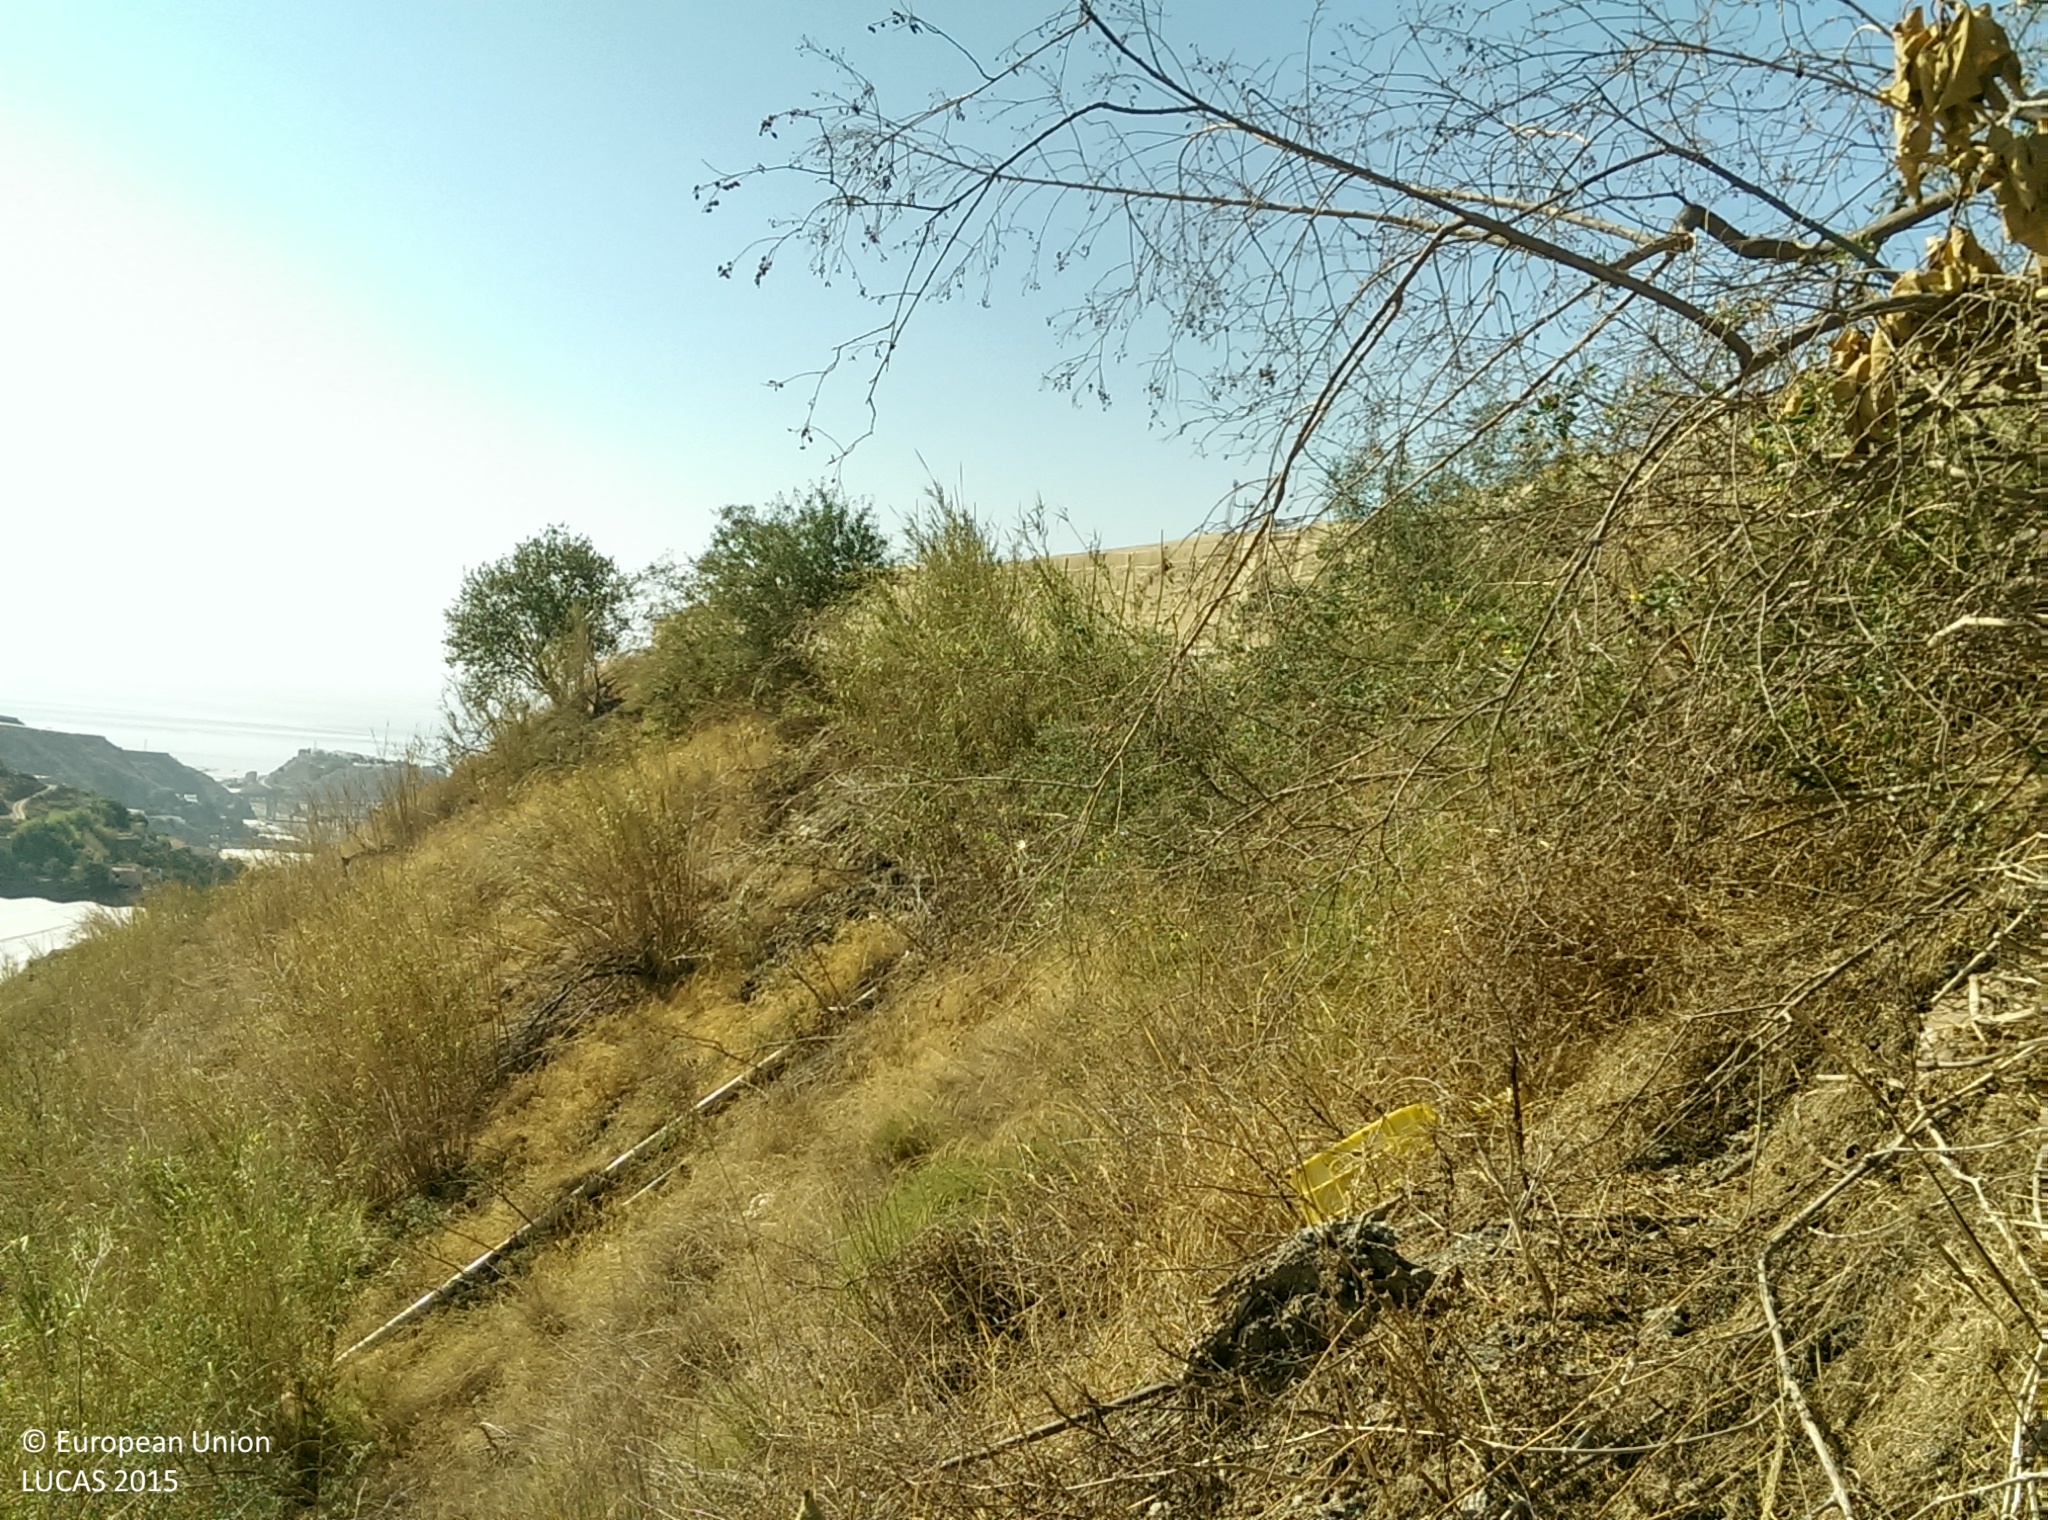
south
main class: Cropland
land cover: Nuts trees
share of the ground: 10 - 25 %
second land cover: Spontaneously vegetated surfaces
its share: > 75 %
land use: Abandoned areas
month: August
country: ES
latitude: 36.7697
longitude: -3.1878
